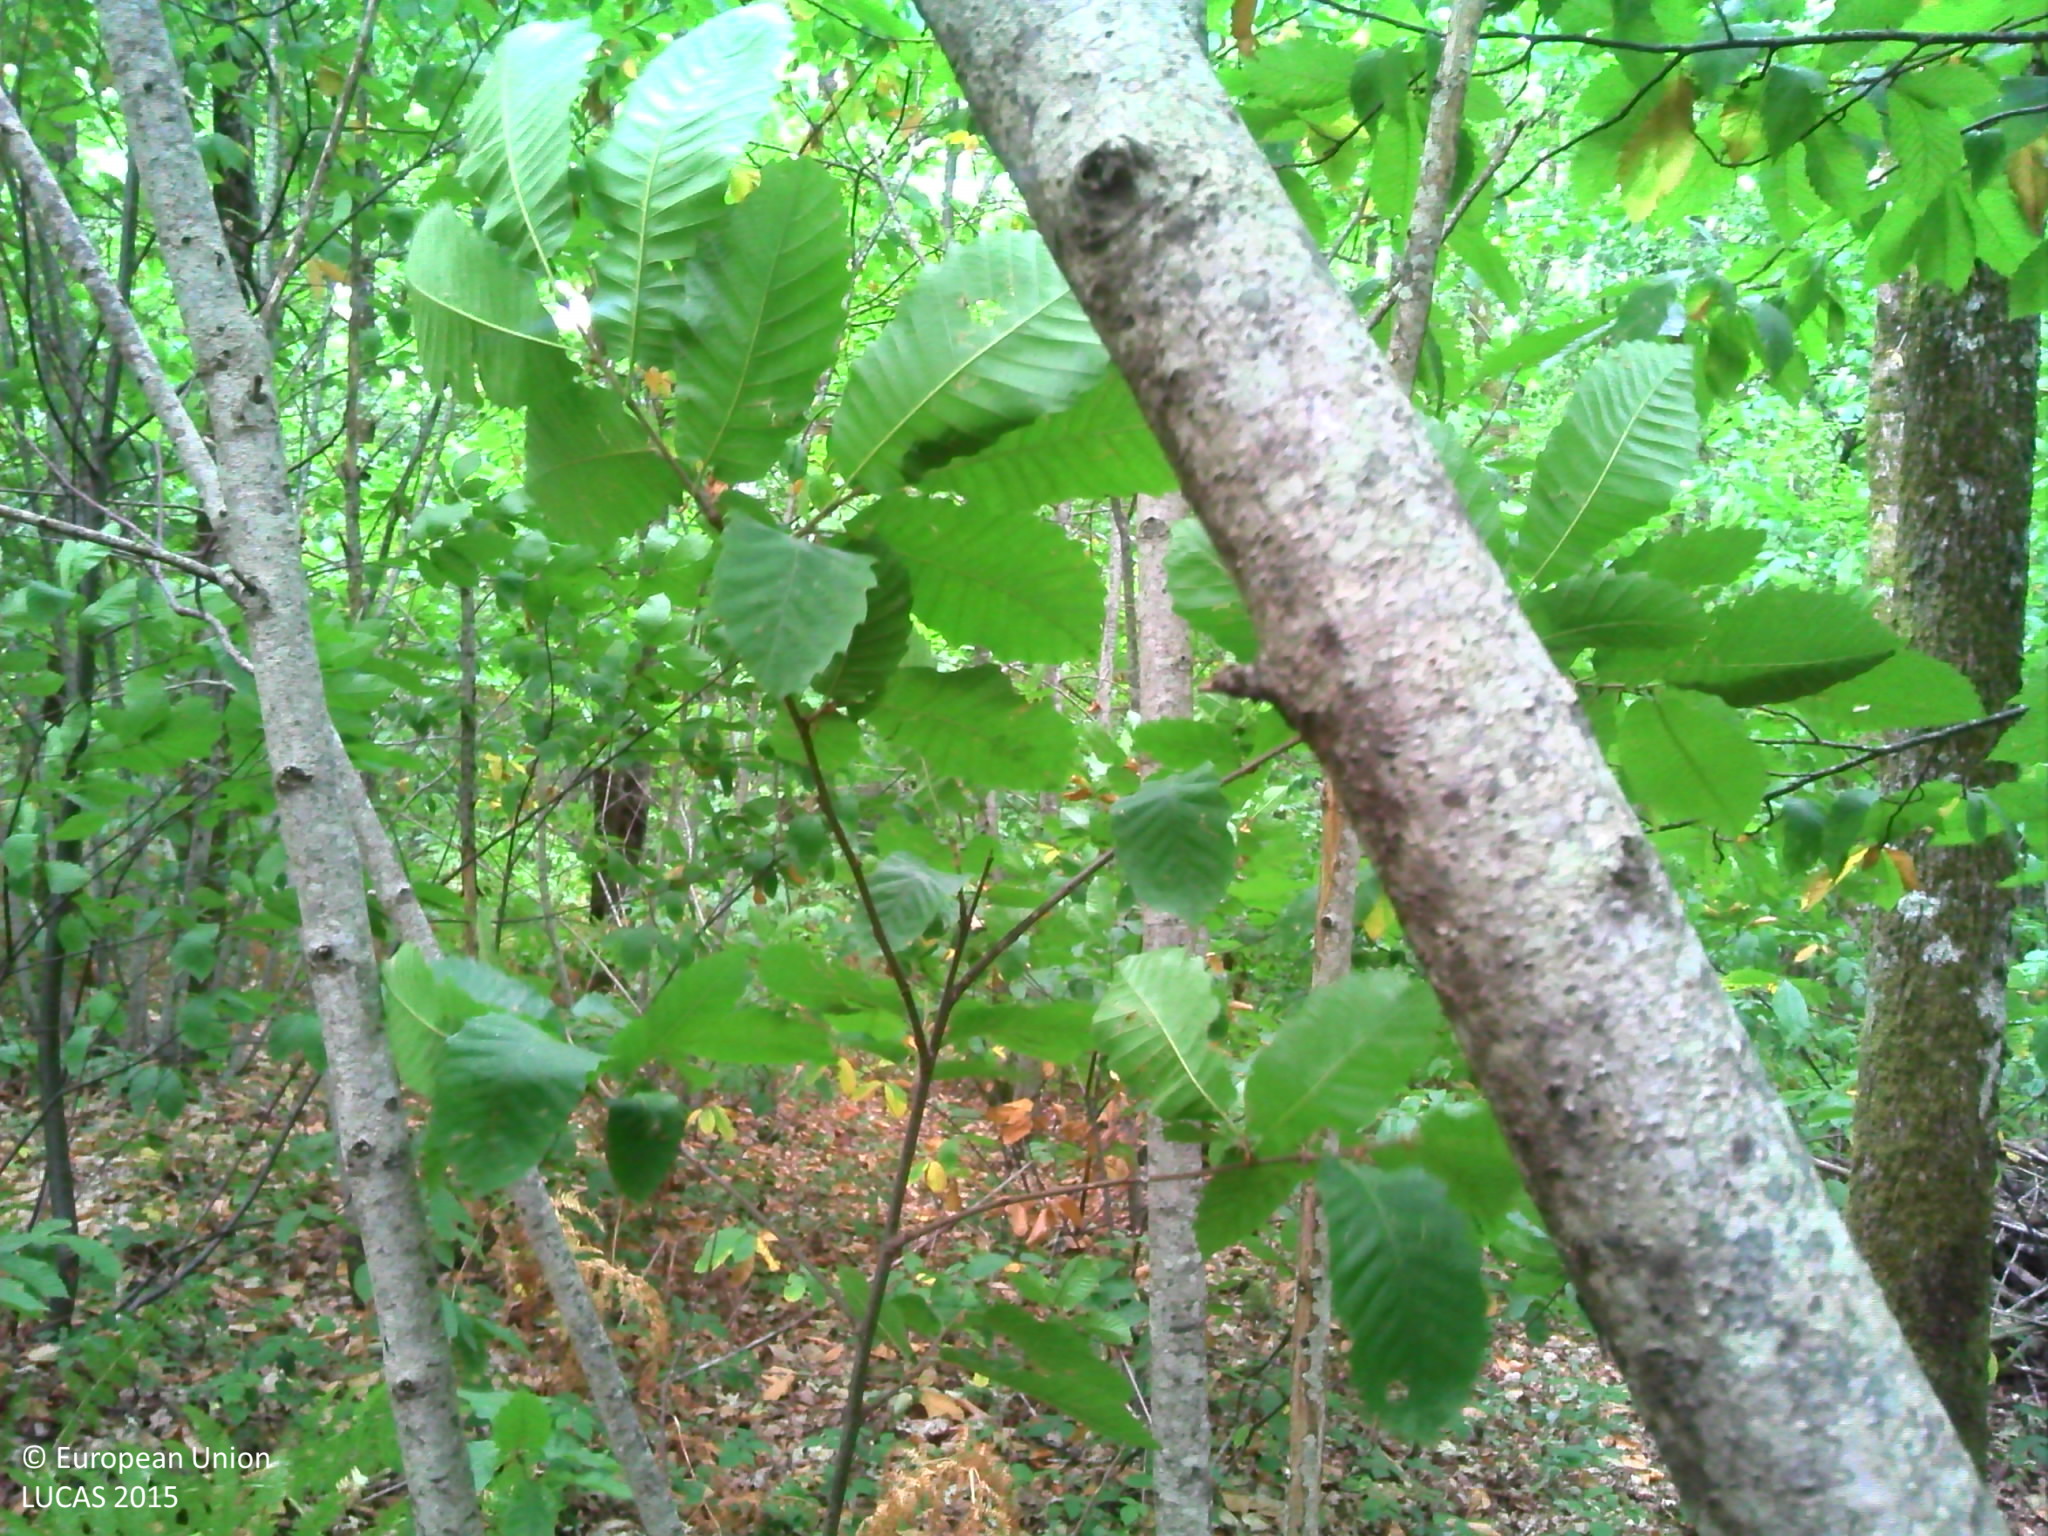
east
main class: Woodland
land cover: Broadleaved woodland
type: mesophytic deciduous forest
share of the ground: > 75 %
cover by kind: broadleaved forest trees 70 %, herbaceous plants 10 %, lichens and mosses 10 %, unconsolidated bare surface 10 %
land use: Forestry
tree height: > 5 m
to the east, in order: Broadleaved woodland; Fences; Broadleaved woodland; Tracks; Broadleaved woodland
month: July
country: FR
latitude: 45.6292
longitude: 0.6107
